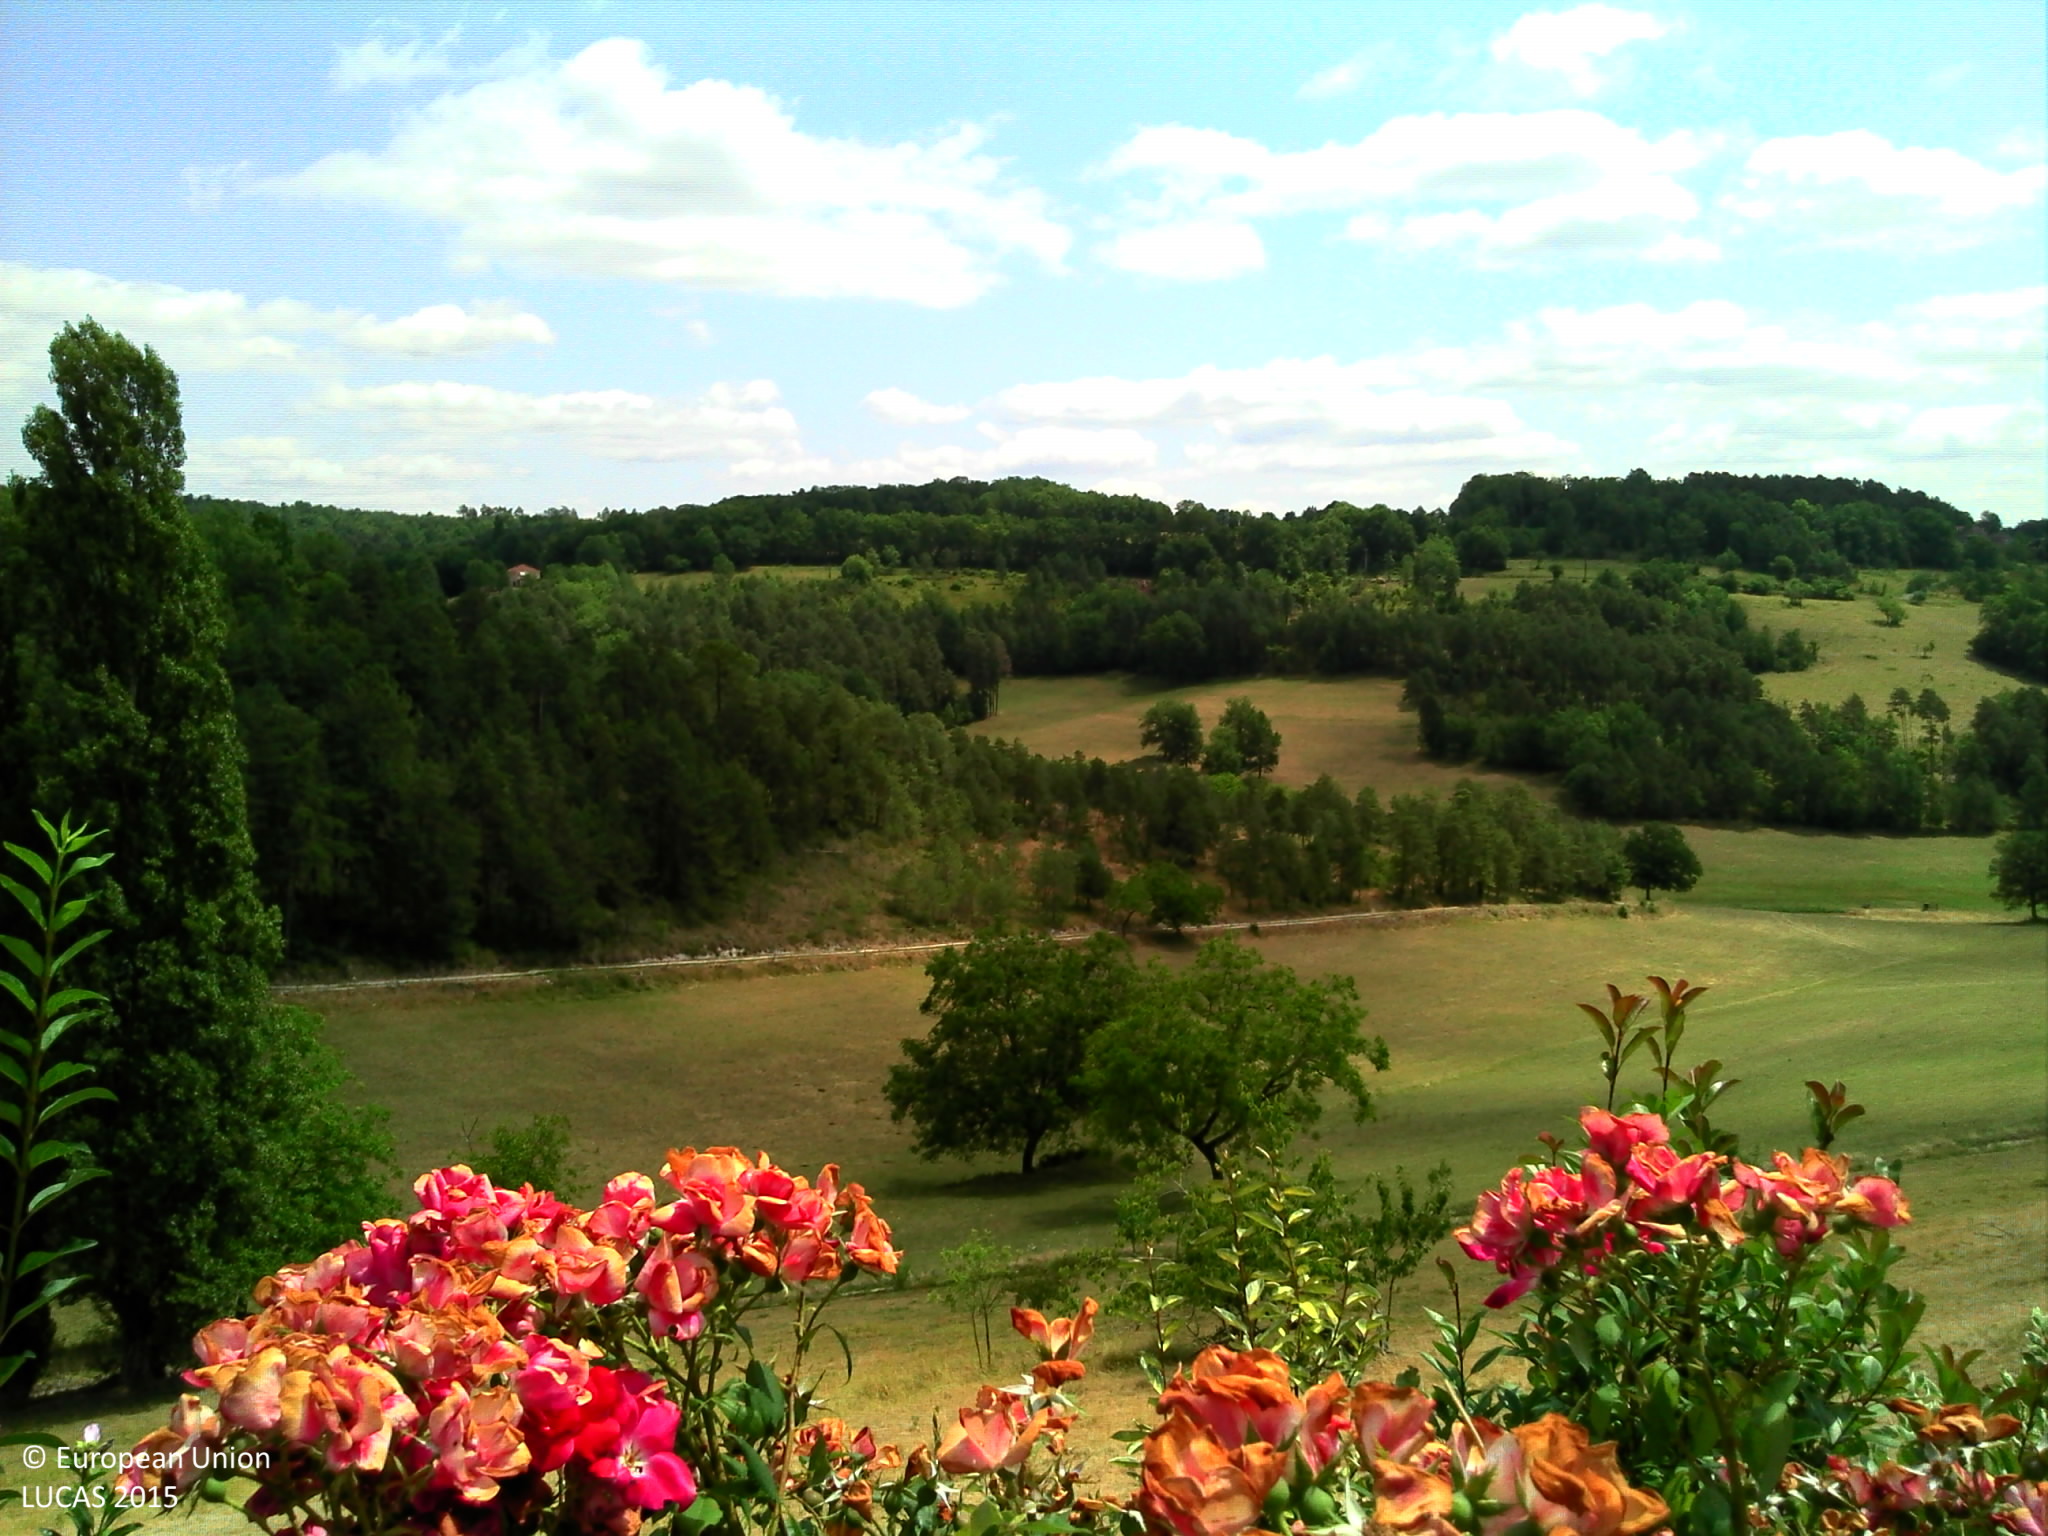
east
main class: Grassland
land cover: Grassland without tree/shrub cover
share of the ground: > 75 %
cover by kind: herbaceous plants 100 %
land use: Agriculture (excluding fallow land and kitchen gardens)
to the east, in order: Floriculture and ornamental plants; Fences; Grassland without tree/shrub cover; Fences; Tracks; Fences; Grassland without tree/shrub cover; Single bushes/trees; Grassland without tree/shrub cover; Fences; Tracks; Fences; Spruce dominated mixed woodland
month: July
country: FR
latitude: 45.0905
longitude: 1.0862
